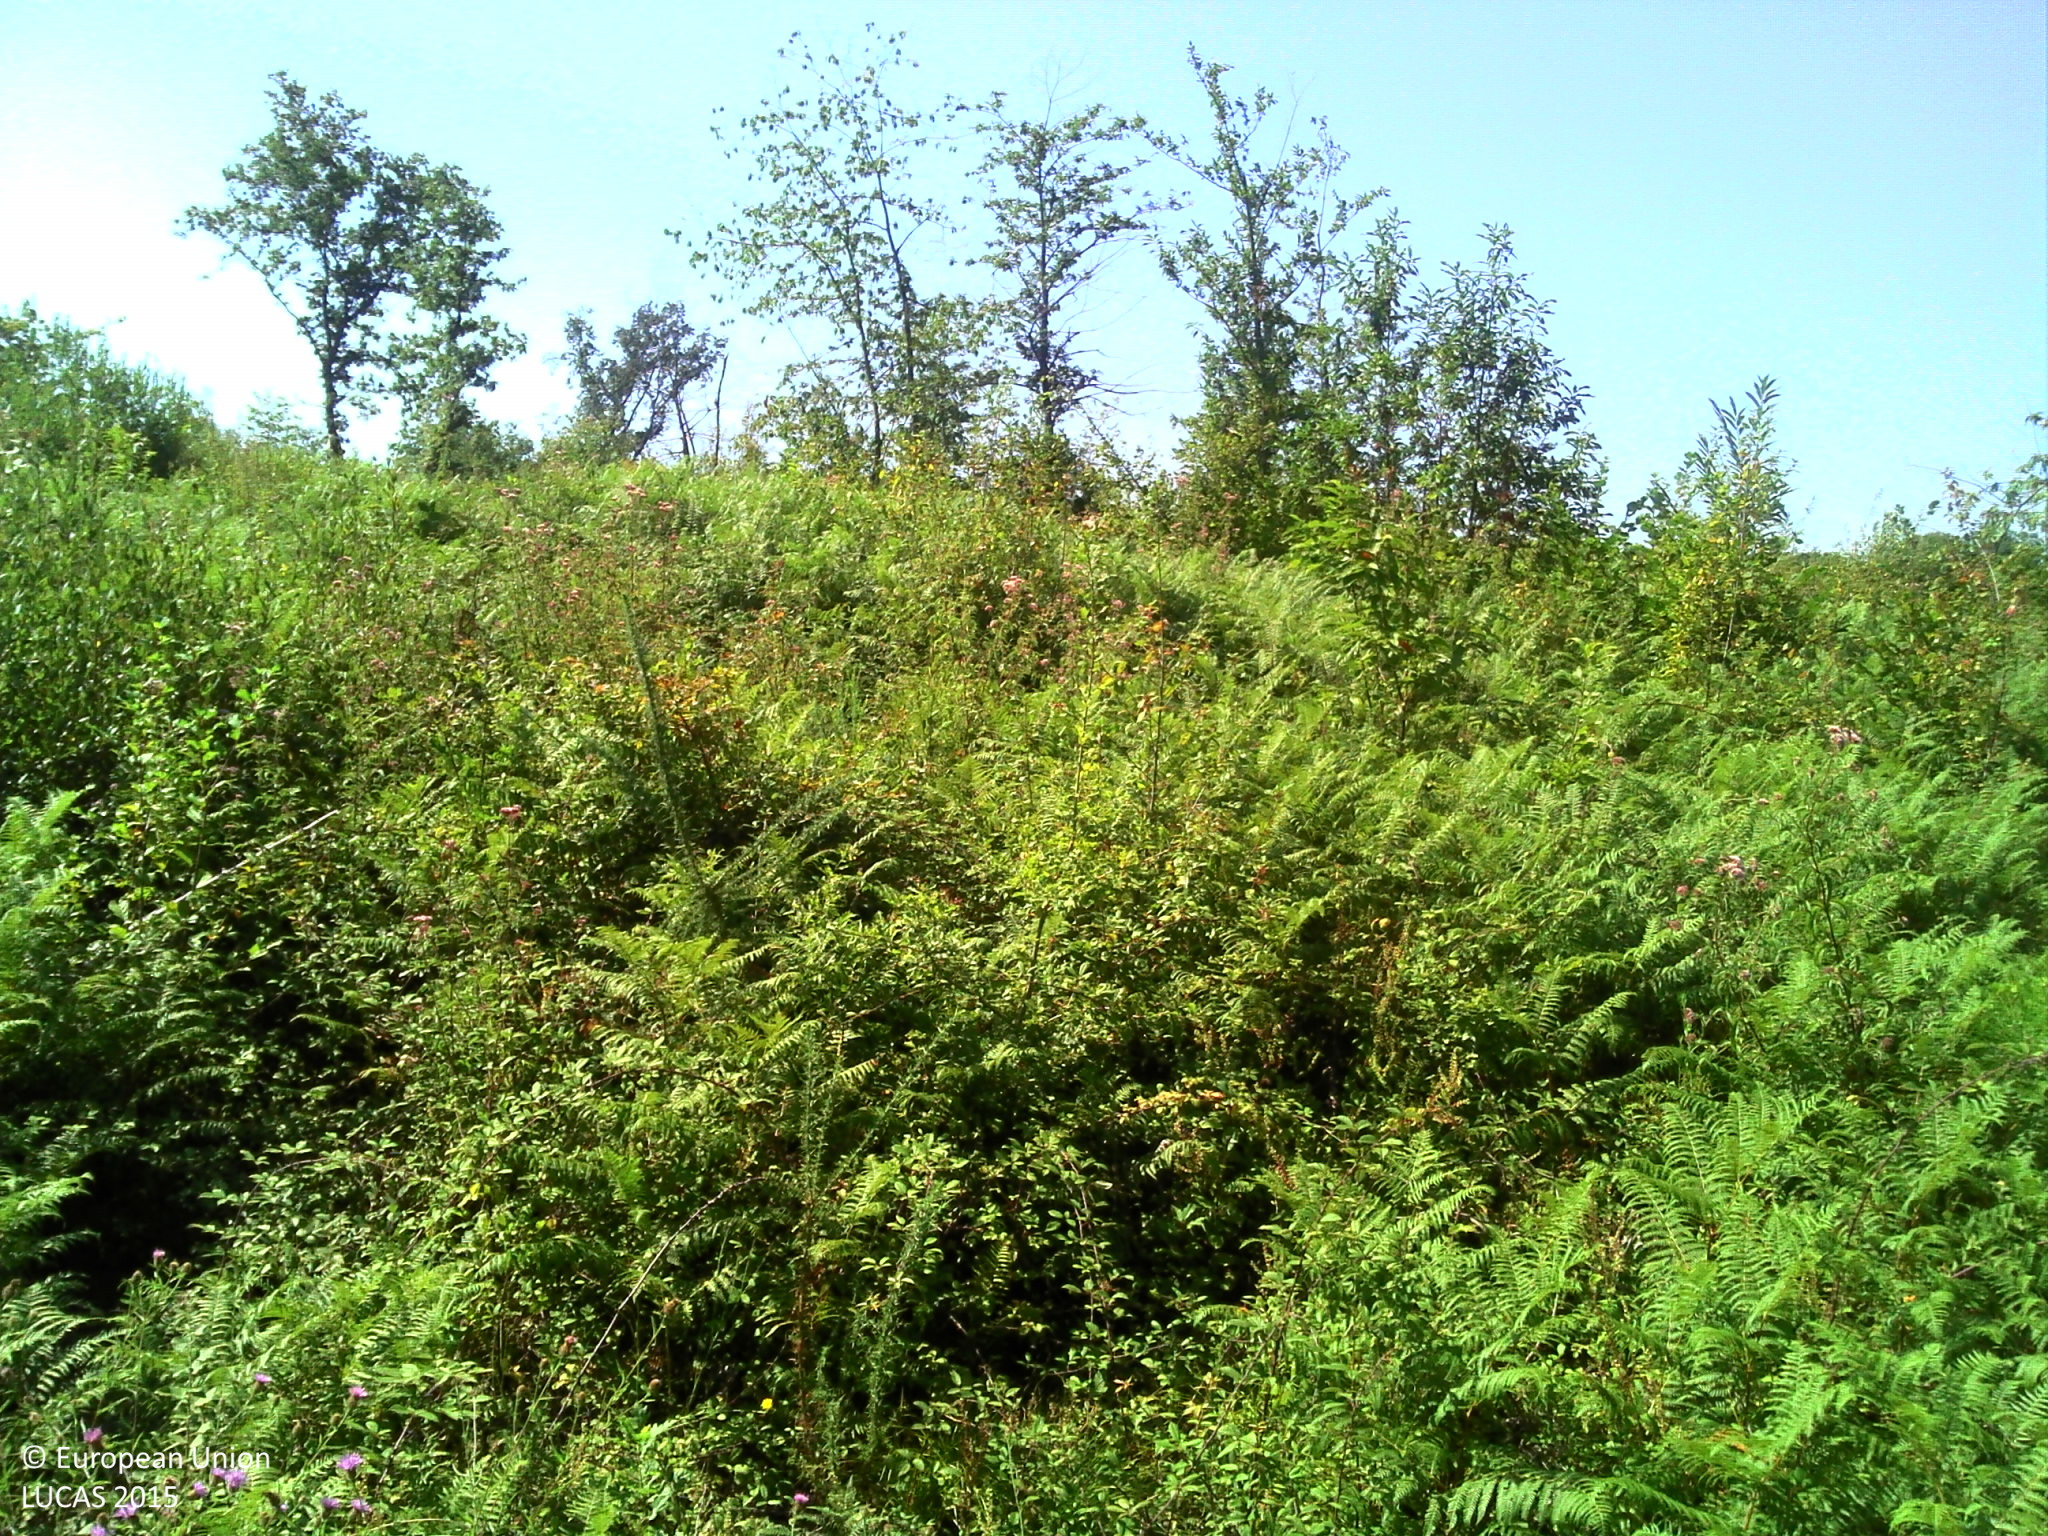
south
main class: Shrubland
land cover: Shrubland with sparse tree cover
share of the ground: > 75 %
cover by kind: herbaceous plants 65 %, shrubs 30 %, broadleaved forest trees 5 %
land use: Forestry
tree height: > 5 m
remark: Clear cut
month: August
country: FR
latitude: 43.4441
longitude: -1.0976
